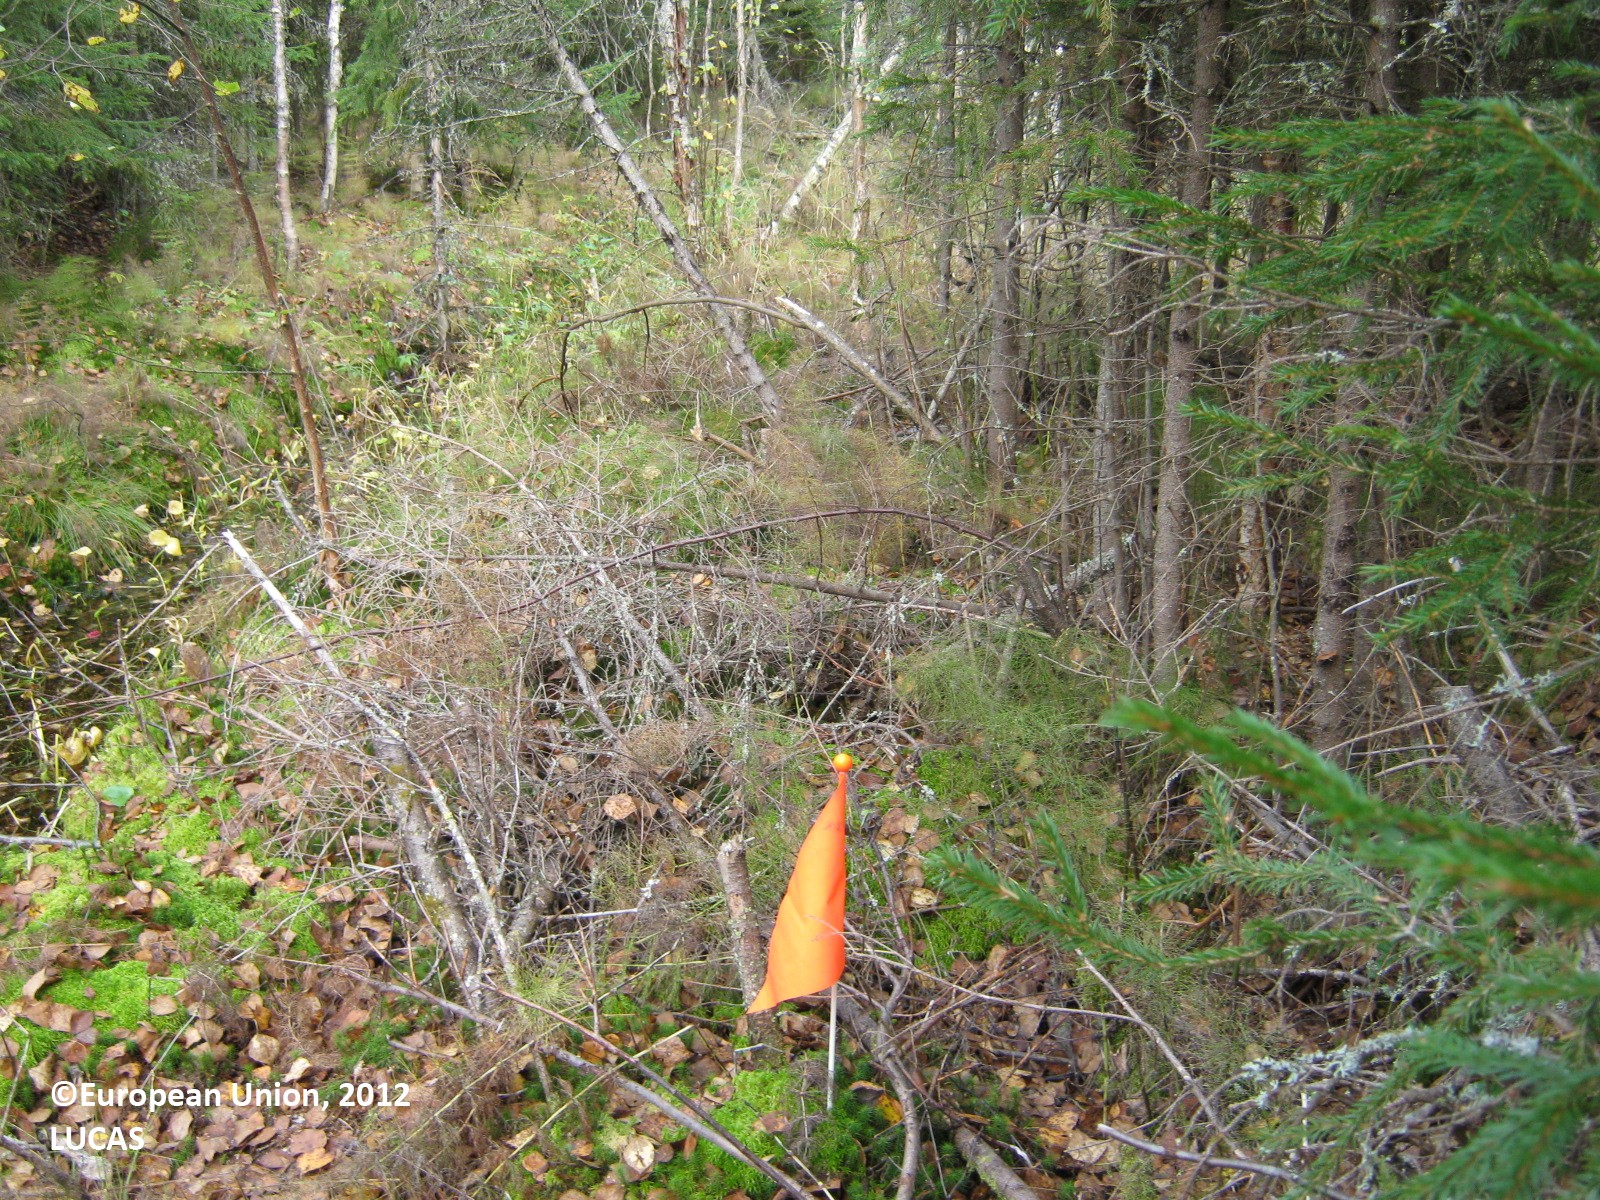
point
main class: Woodland
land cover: Spruce dominated mixed woodland
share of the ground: > 75 %
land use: Forestry
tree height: < 5 m
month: September
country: FI
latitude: 60.9126
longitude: 28.1855
